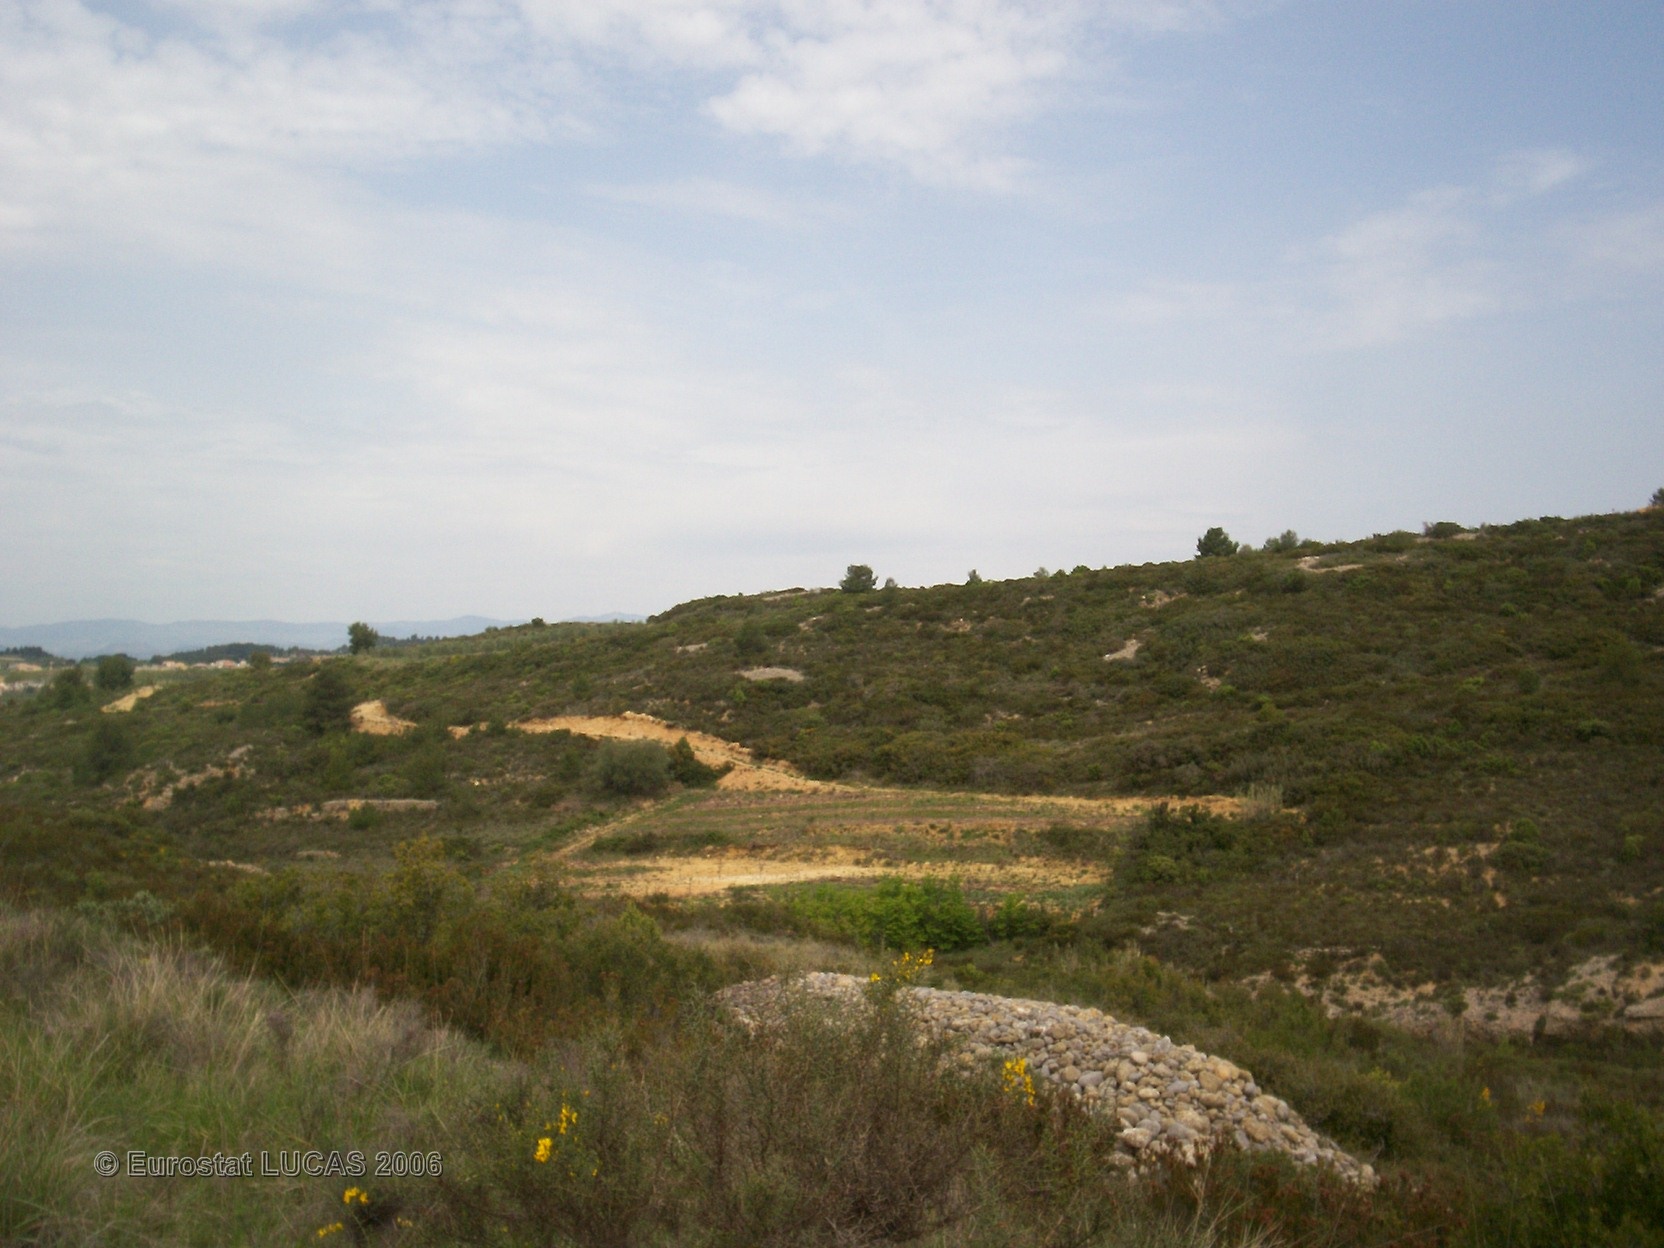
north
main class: Grassland
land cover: Grassland with sparse tree/shrub cover
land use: Unused
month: April
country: FR
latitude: 43.5159
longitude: 3.5393
